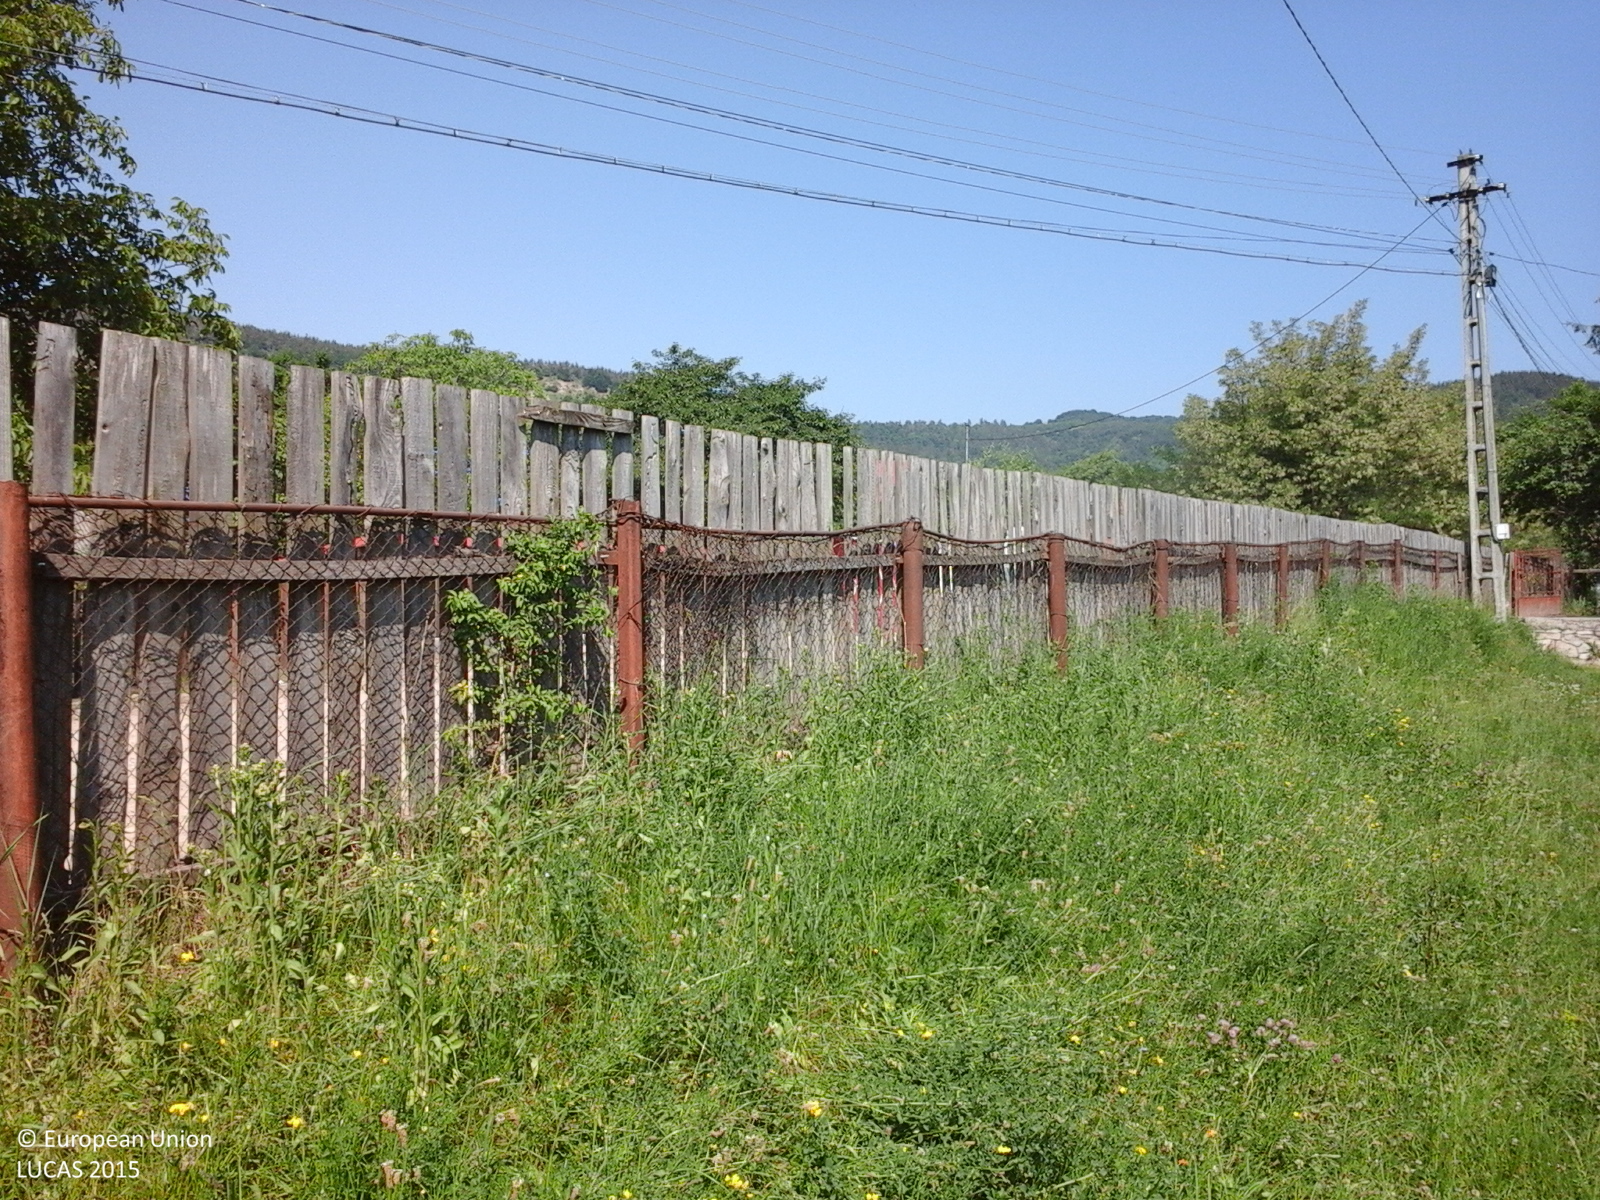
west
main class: Artificial land
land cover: Non built-up area features
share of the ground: > 75 %
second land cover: Grassland without tree/shrub cover
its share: > 75 %
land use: Sport
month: June
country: RO
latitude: 46.3216
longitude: 26.6441
